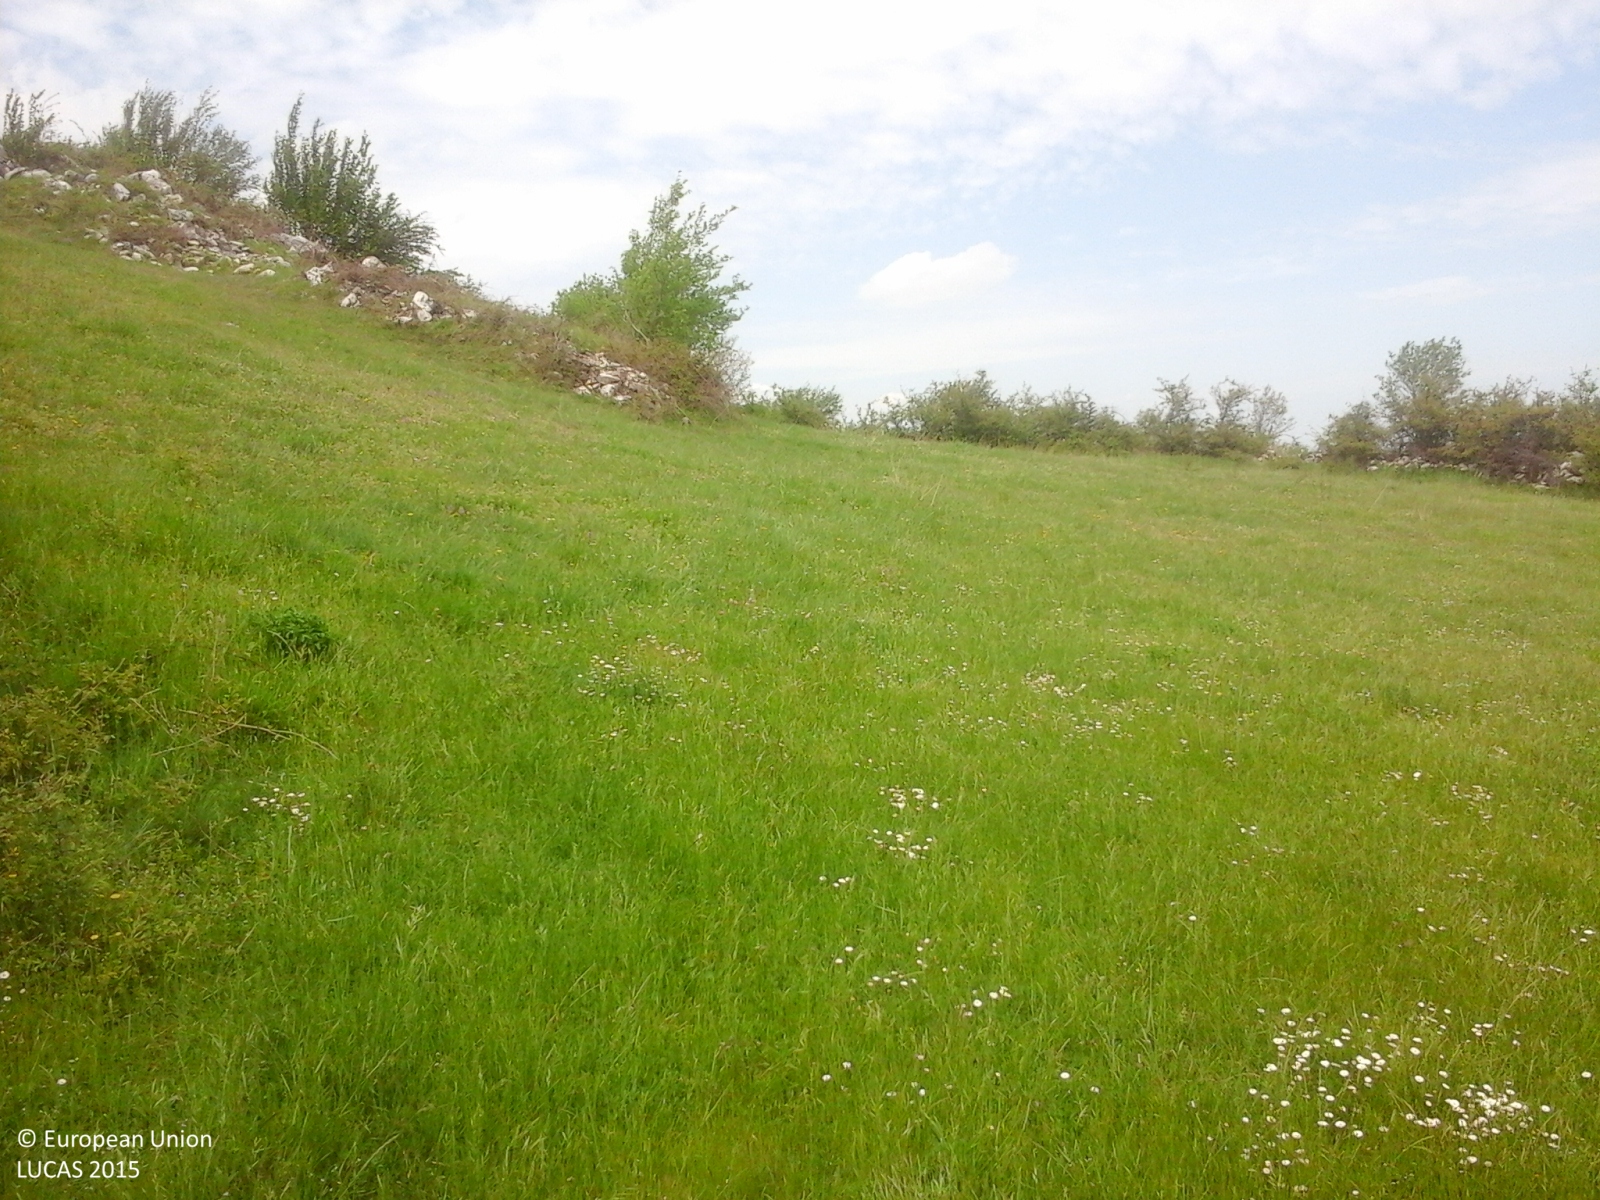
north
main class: Grassland
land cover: Grassland without tree/shrub cover
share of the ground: > 75 %
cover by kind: herbaceous plants 100 %
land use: Agriculture (excluding fallow land and kitchen gardens)
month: May
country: IT
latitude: 41.3356
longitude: 14.6313
